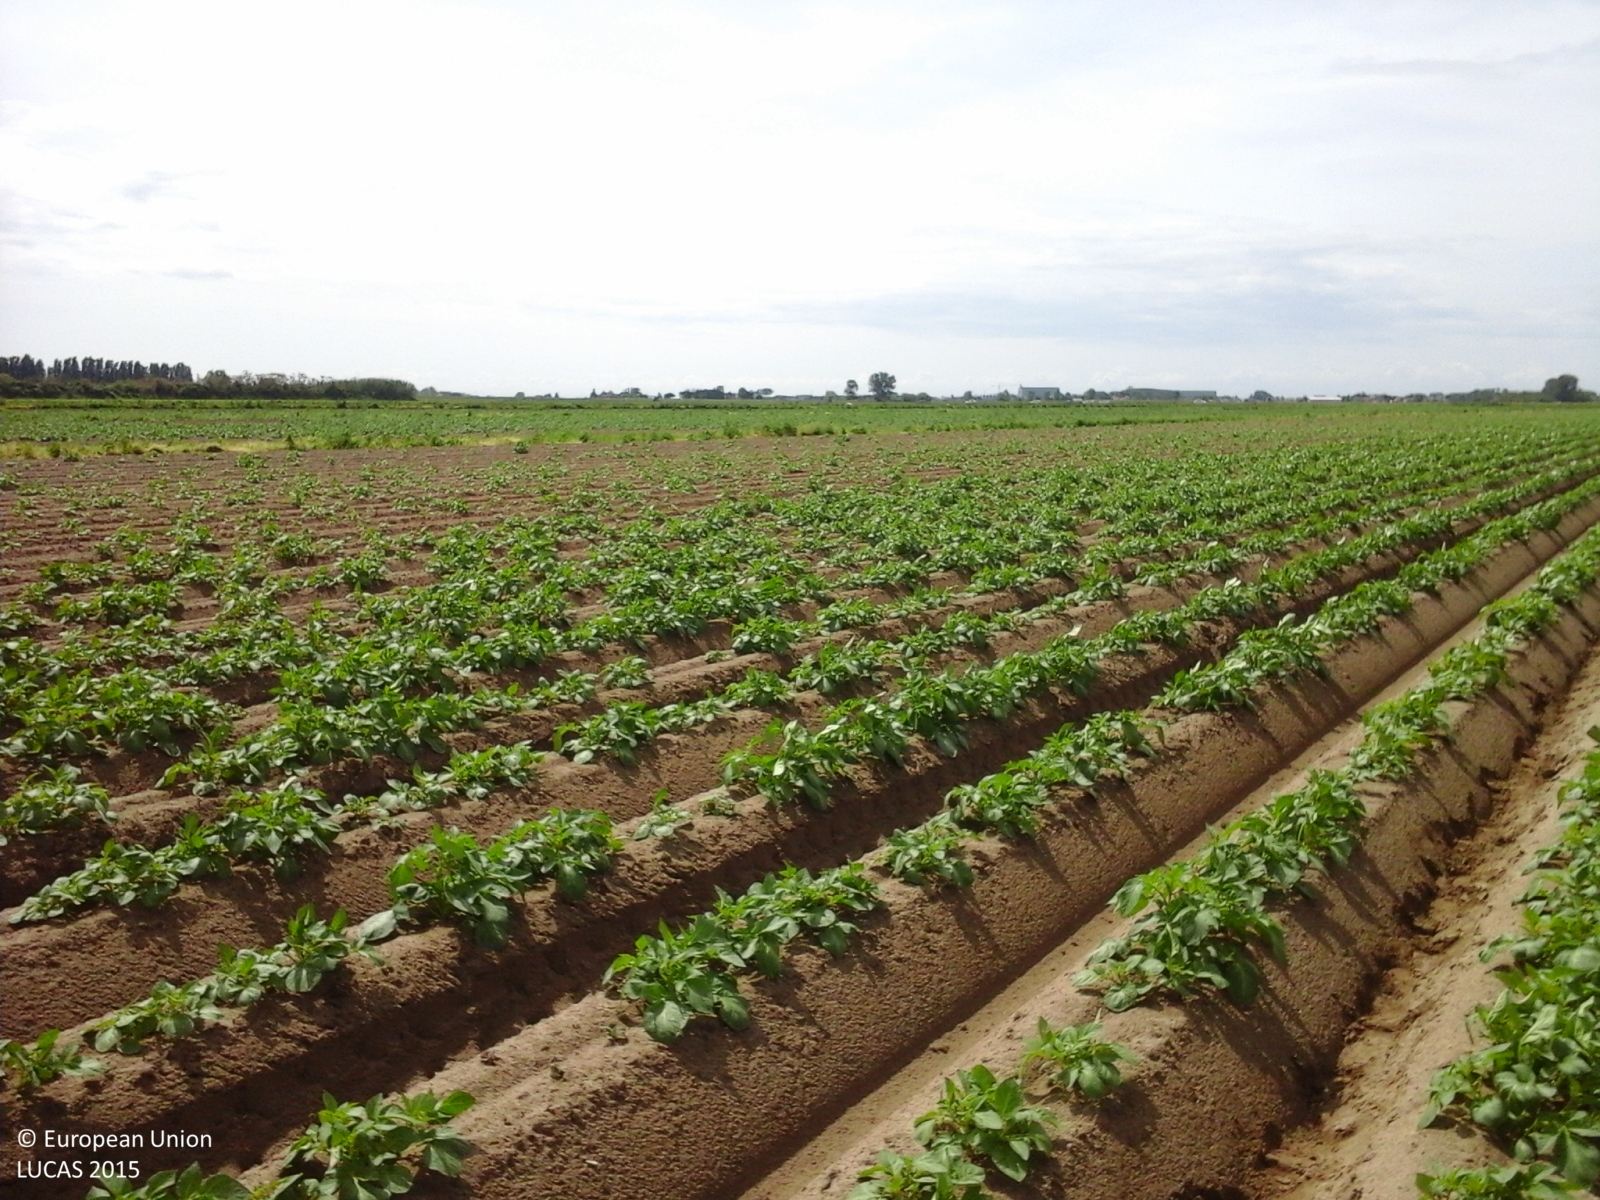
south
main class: Cropland
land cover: Potatoes
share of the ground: 25 - 50 %
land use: Agriculture (excluding fallow land and kitchen gardens)
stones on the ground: < 10 %
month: April
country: IT
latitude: 44.8867
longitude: 12.1862
